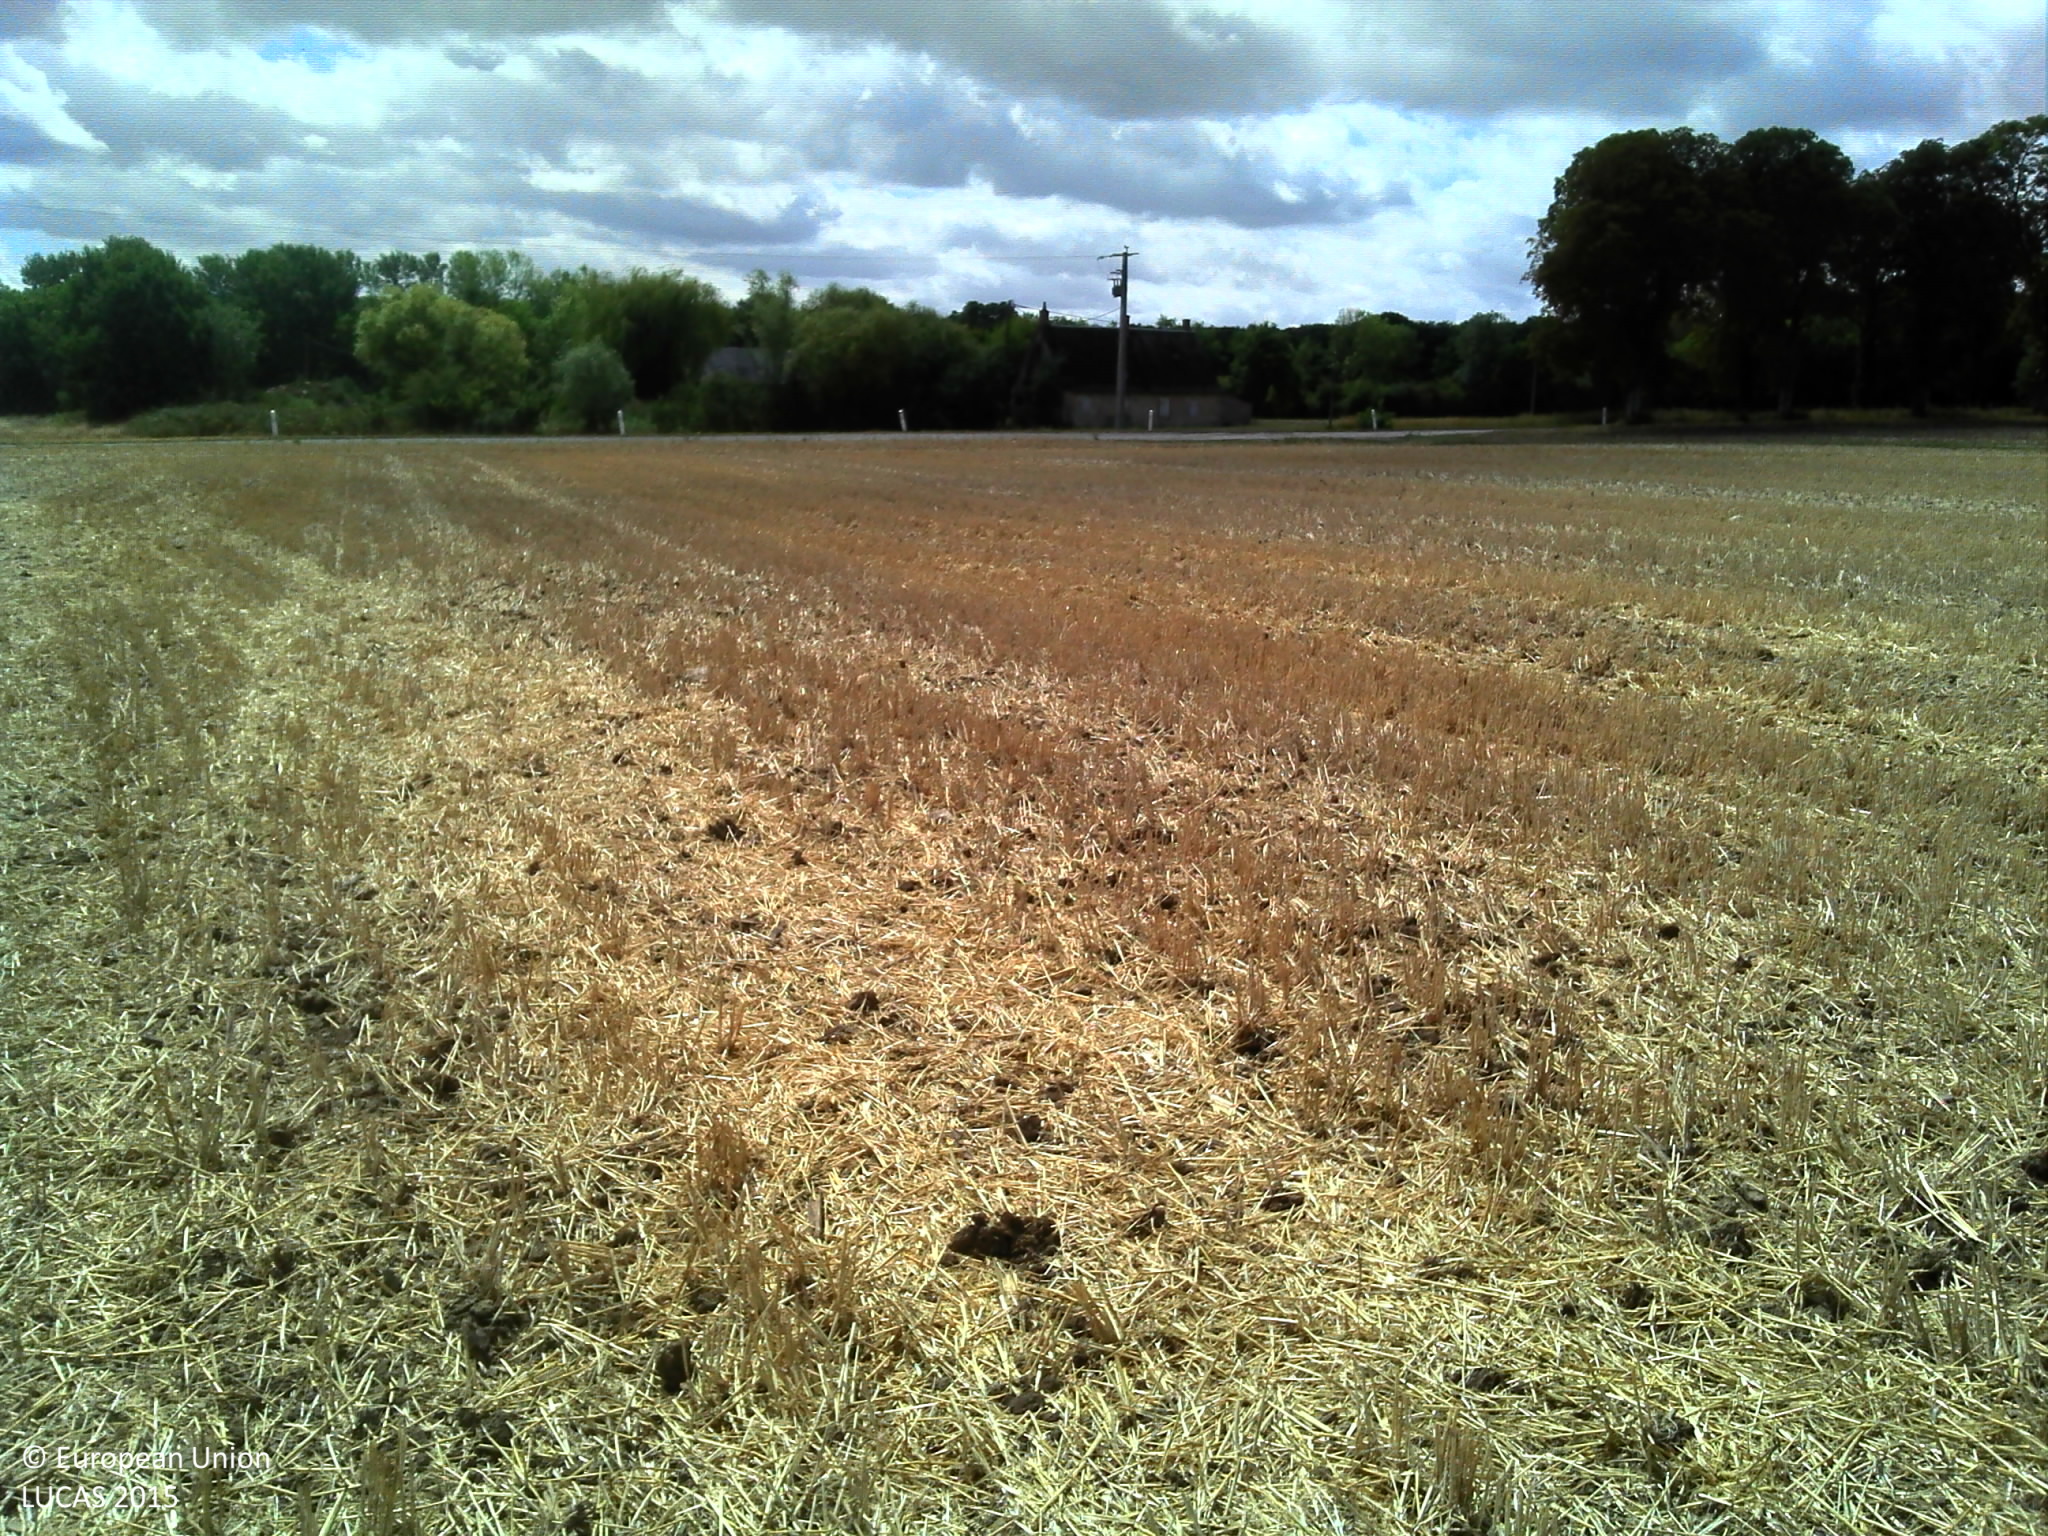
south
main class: Cropland
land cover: Common wheat
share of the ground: > 75 %
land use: Agriculture (excluding fallow land and kitchen gardens)
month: August
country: FR
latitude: 47.1436
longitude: 2.0922
